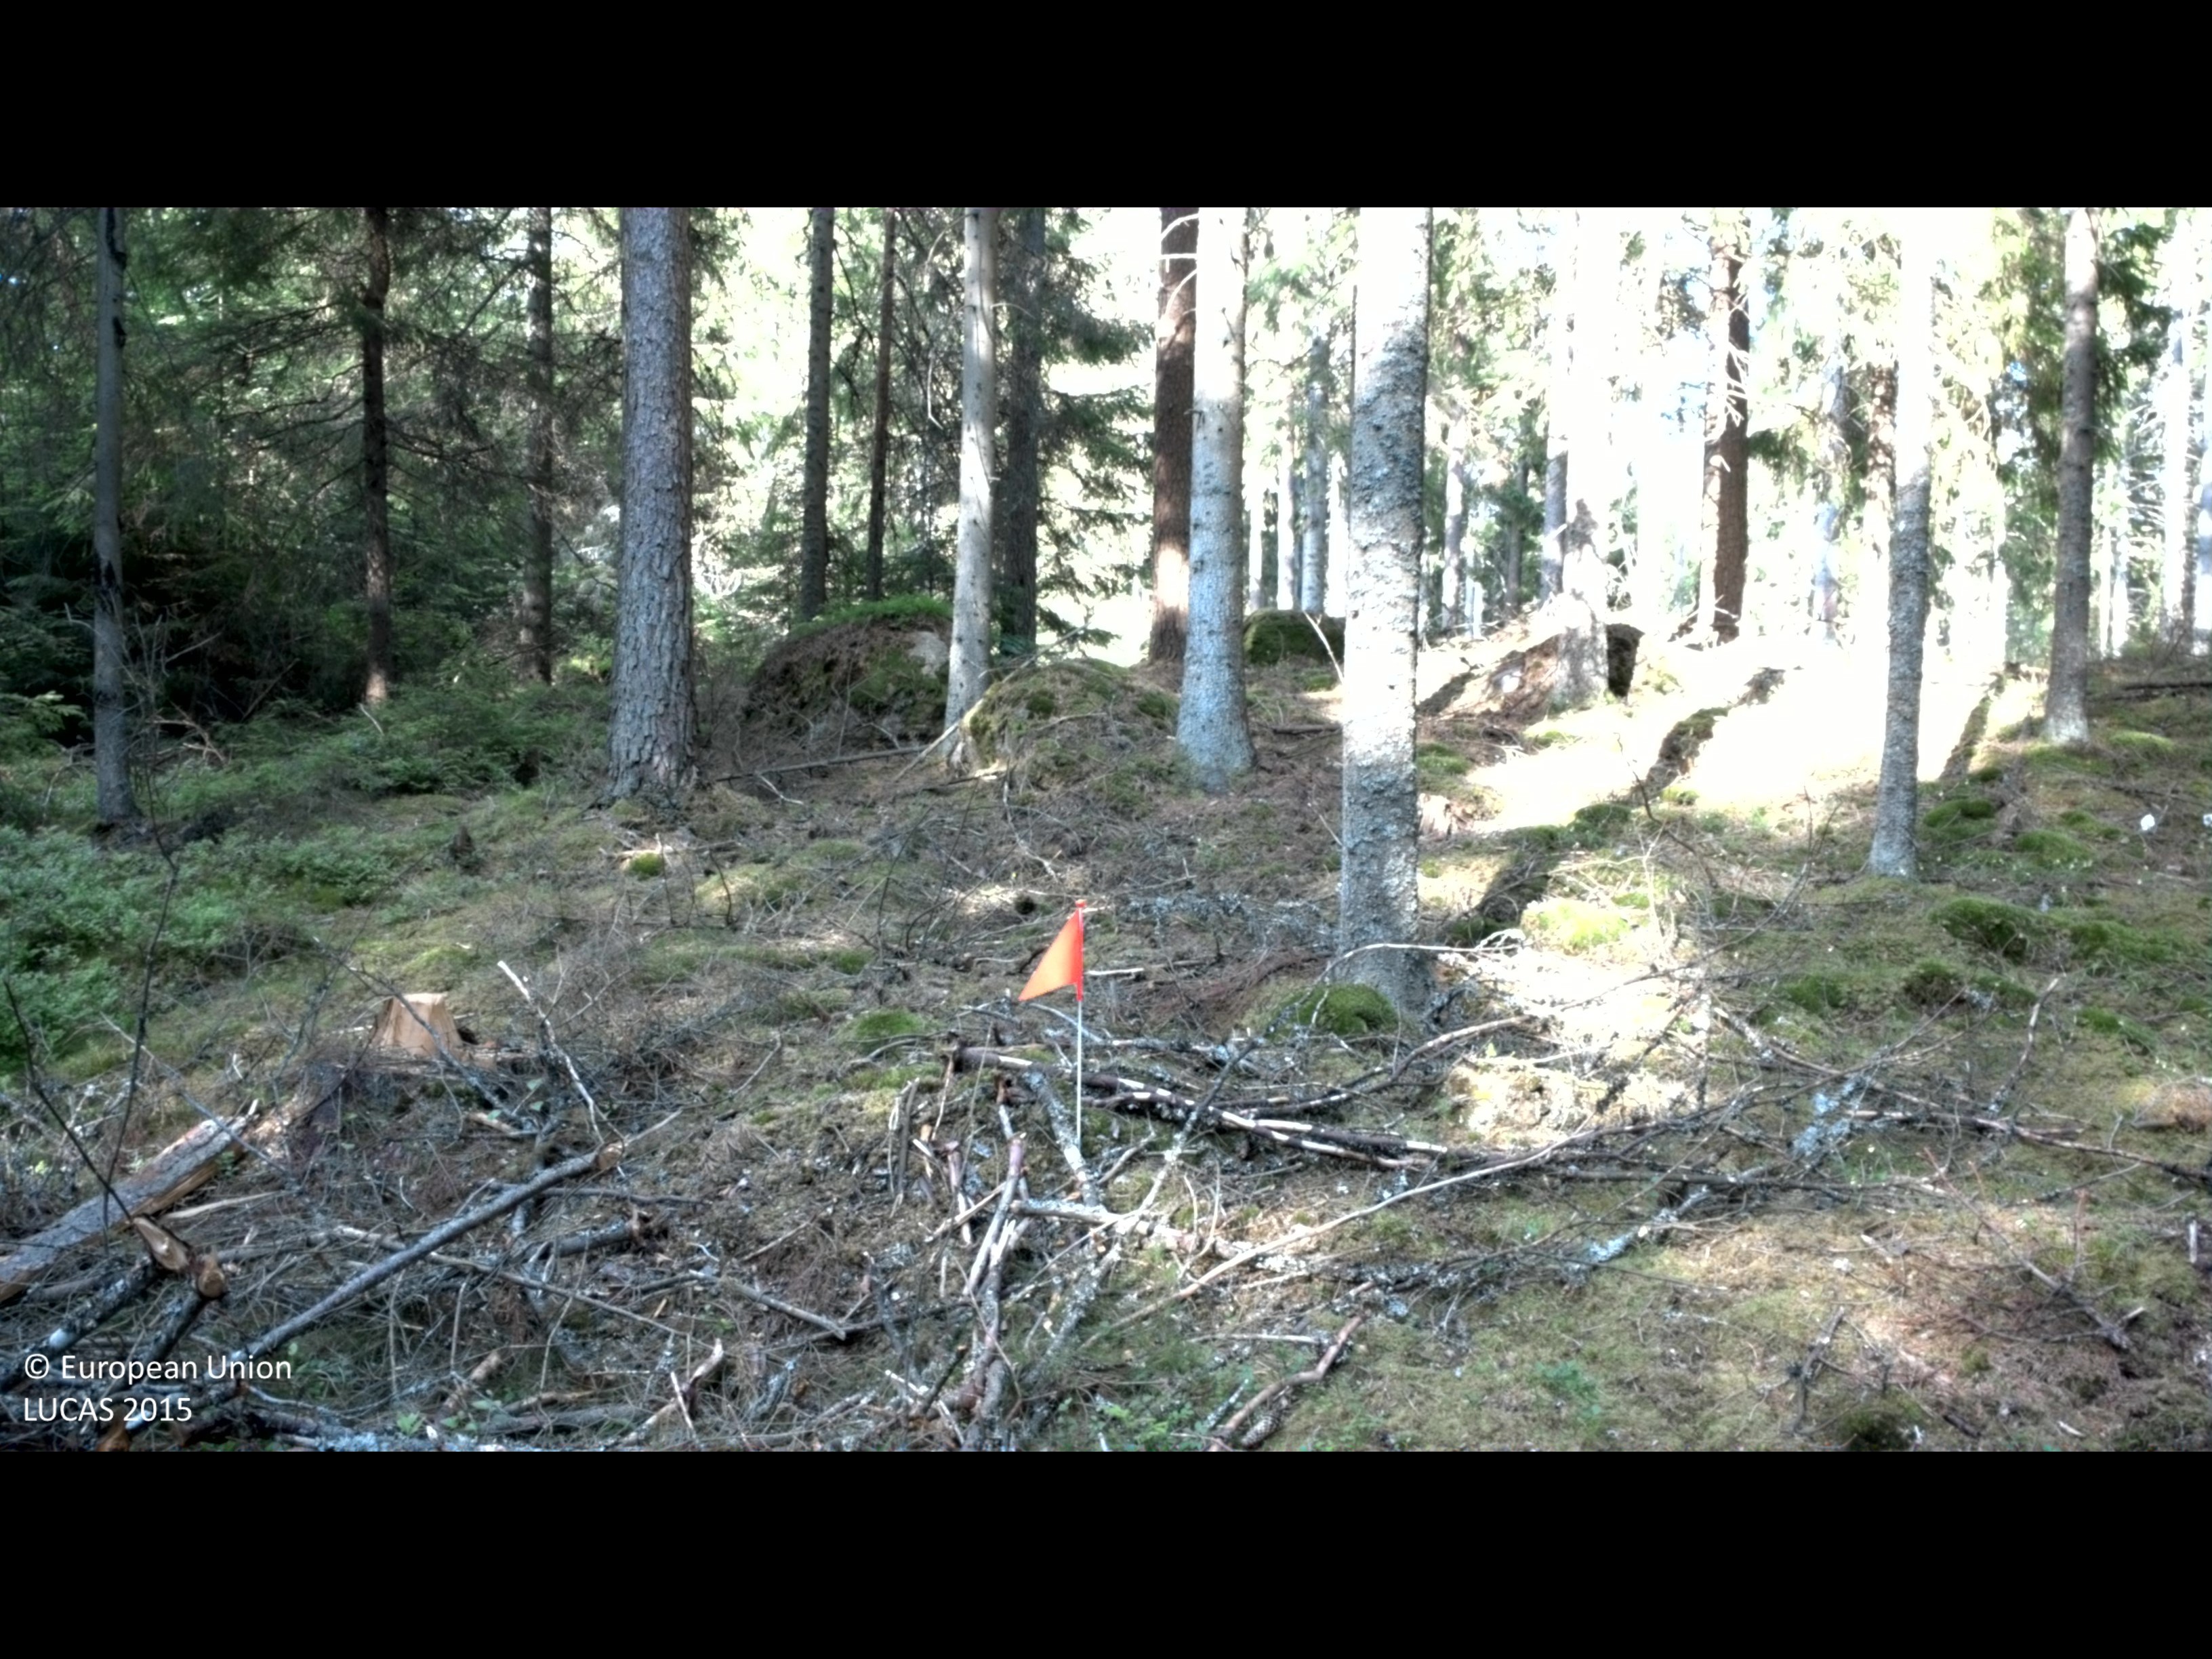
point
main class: Woodland
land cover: Spruce dominated coniferous woodland
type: boreal forest
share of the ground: 50 - 75 %
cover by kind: coniferous forest trees 65 %, shrubs 25 %, broadleaved forest trees 5 %, lichens and mosses 5 %
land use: Forestry
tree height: > 5 m
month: July
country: SE
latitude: 56.4748
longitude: 14.3320
